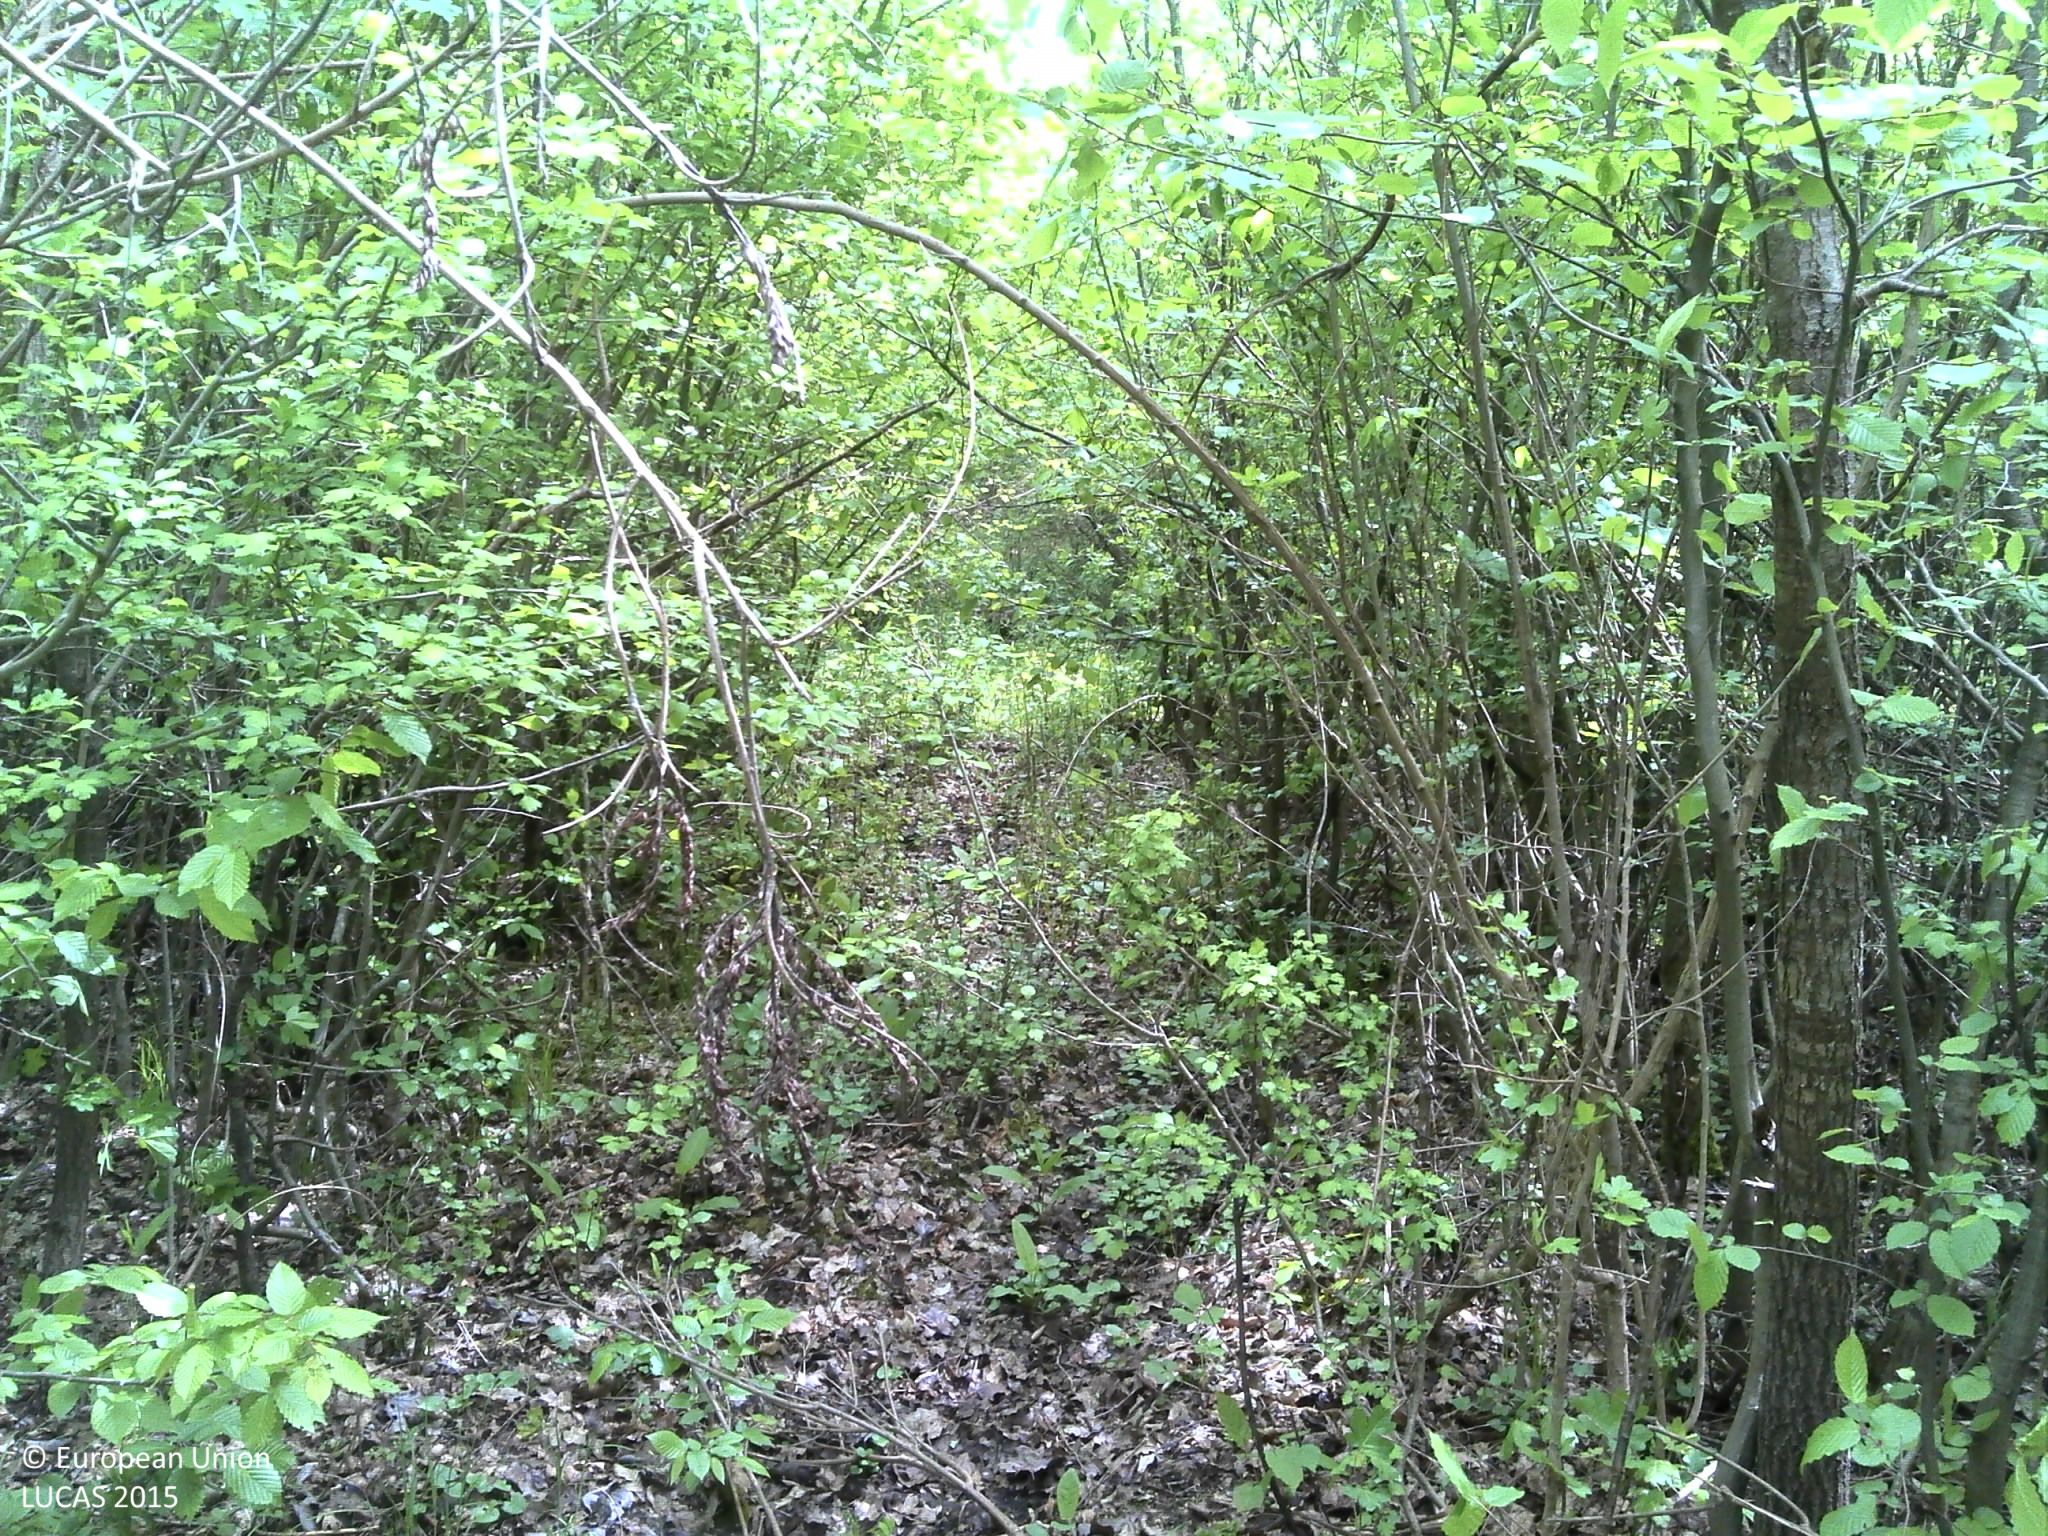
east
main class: Woodland
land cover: Broadleaved woodland
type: mesophytic deciduous forest
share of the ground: > 75 %
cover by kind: broadleaved forest trees 90 %, shrubs 10 %
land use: Forestry
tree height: < 5 m
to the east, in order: Broadleaved woodland
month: April
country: HR
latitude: 45.0439
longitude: 19.0341
